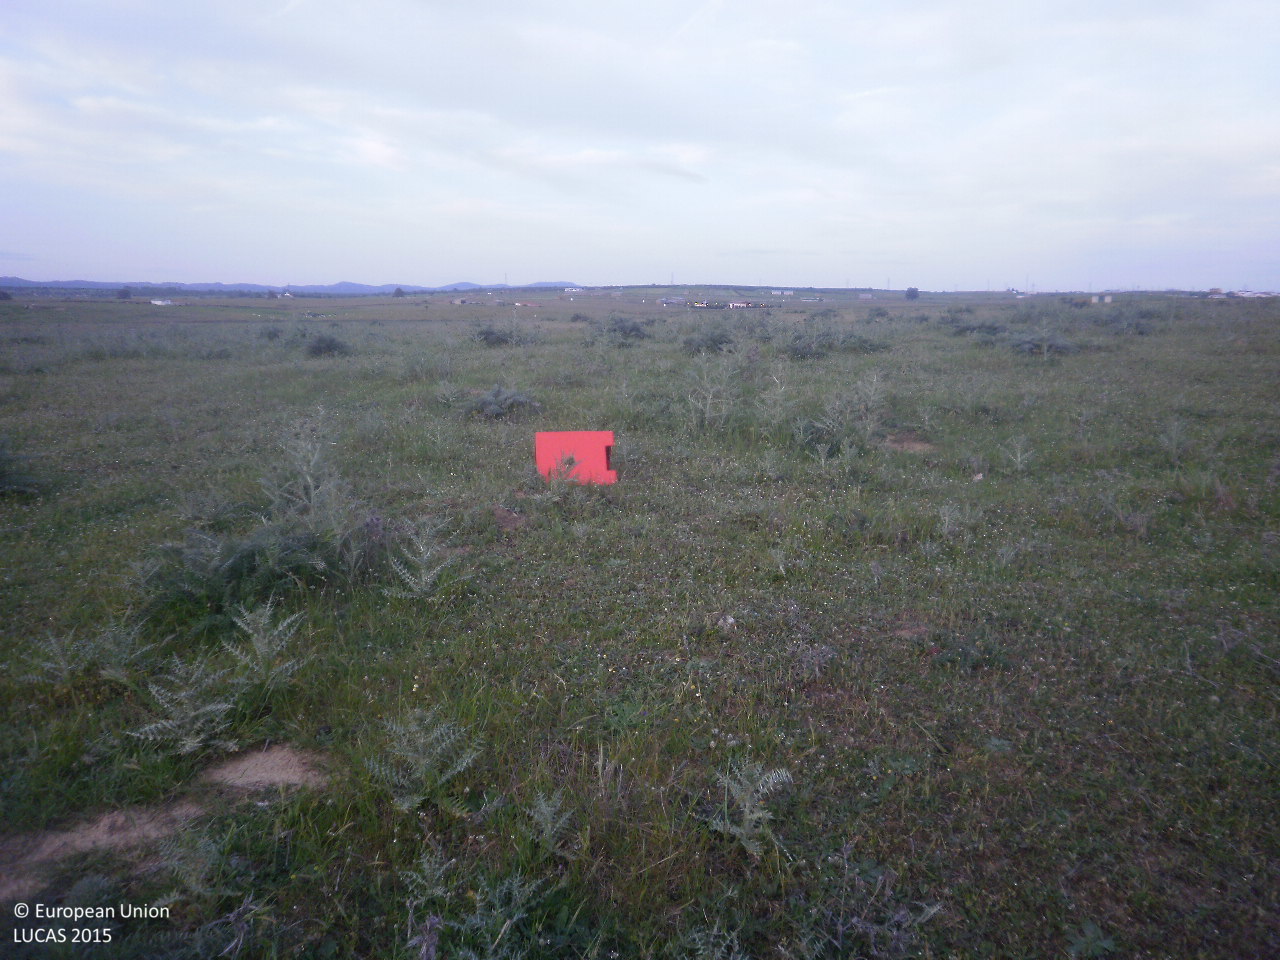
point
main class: Grassland
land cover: Grassland without tree/shrub cover
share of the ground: > 75 %
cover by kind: herbaceous plants 100 %
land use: Agriculture (excluding fallow land and kitchen gardens)
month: April
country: ES
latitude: 39.0477
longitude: -5.2577
